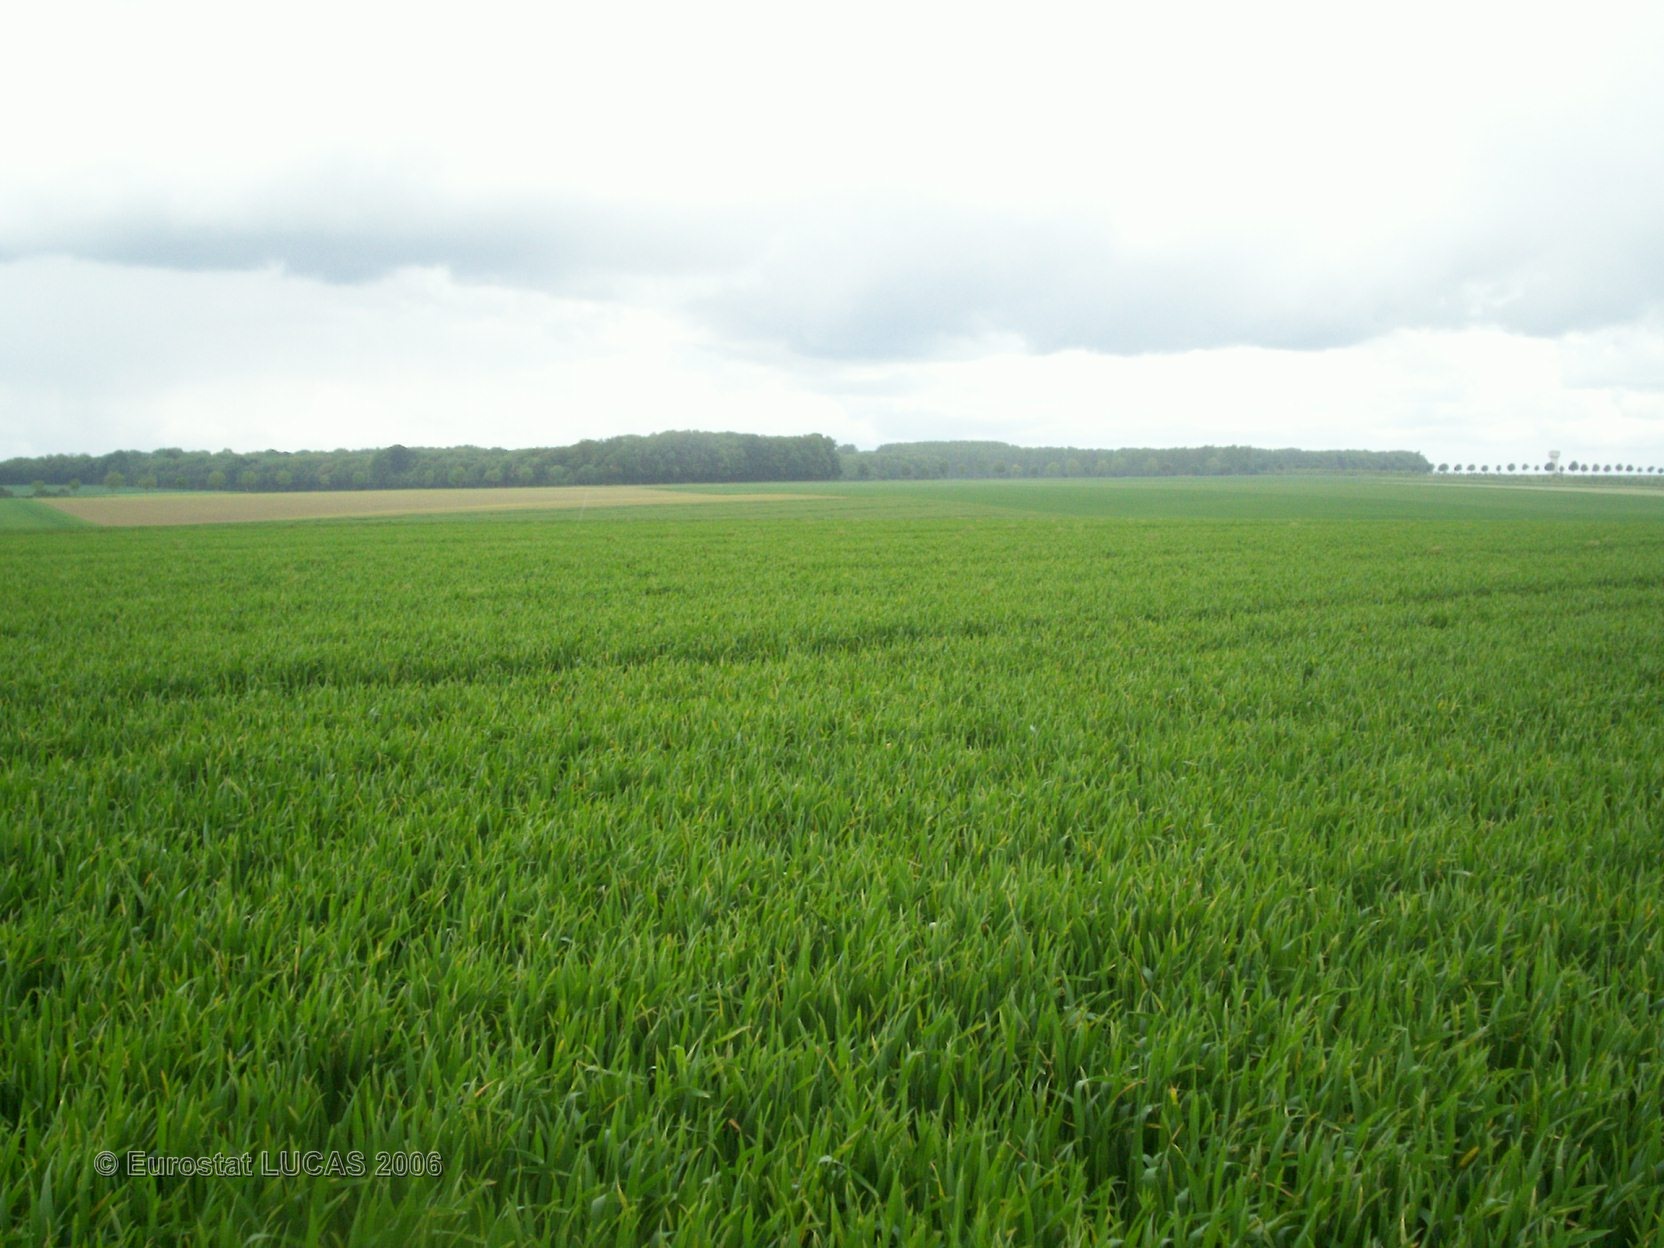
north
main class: Cropland
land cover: Common wheat
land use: Agriculture (excluding fallow land and kitchen gardens)
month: May
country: FR
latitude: 50.1753
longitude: 2.5526
